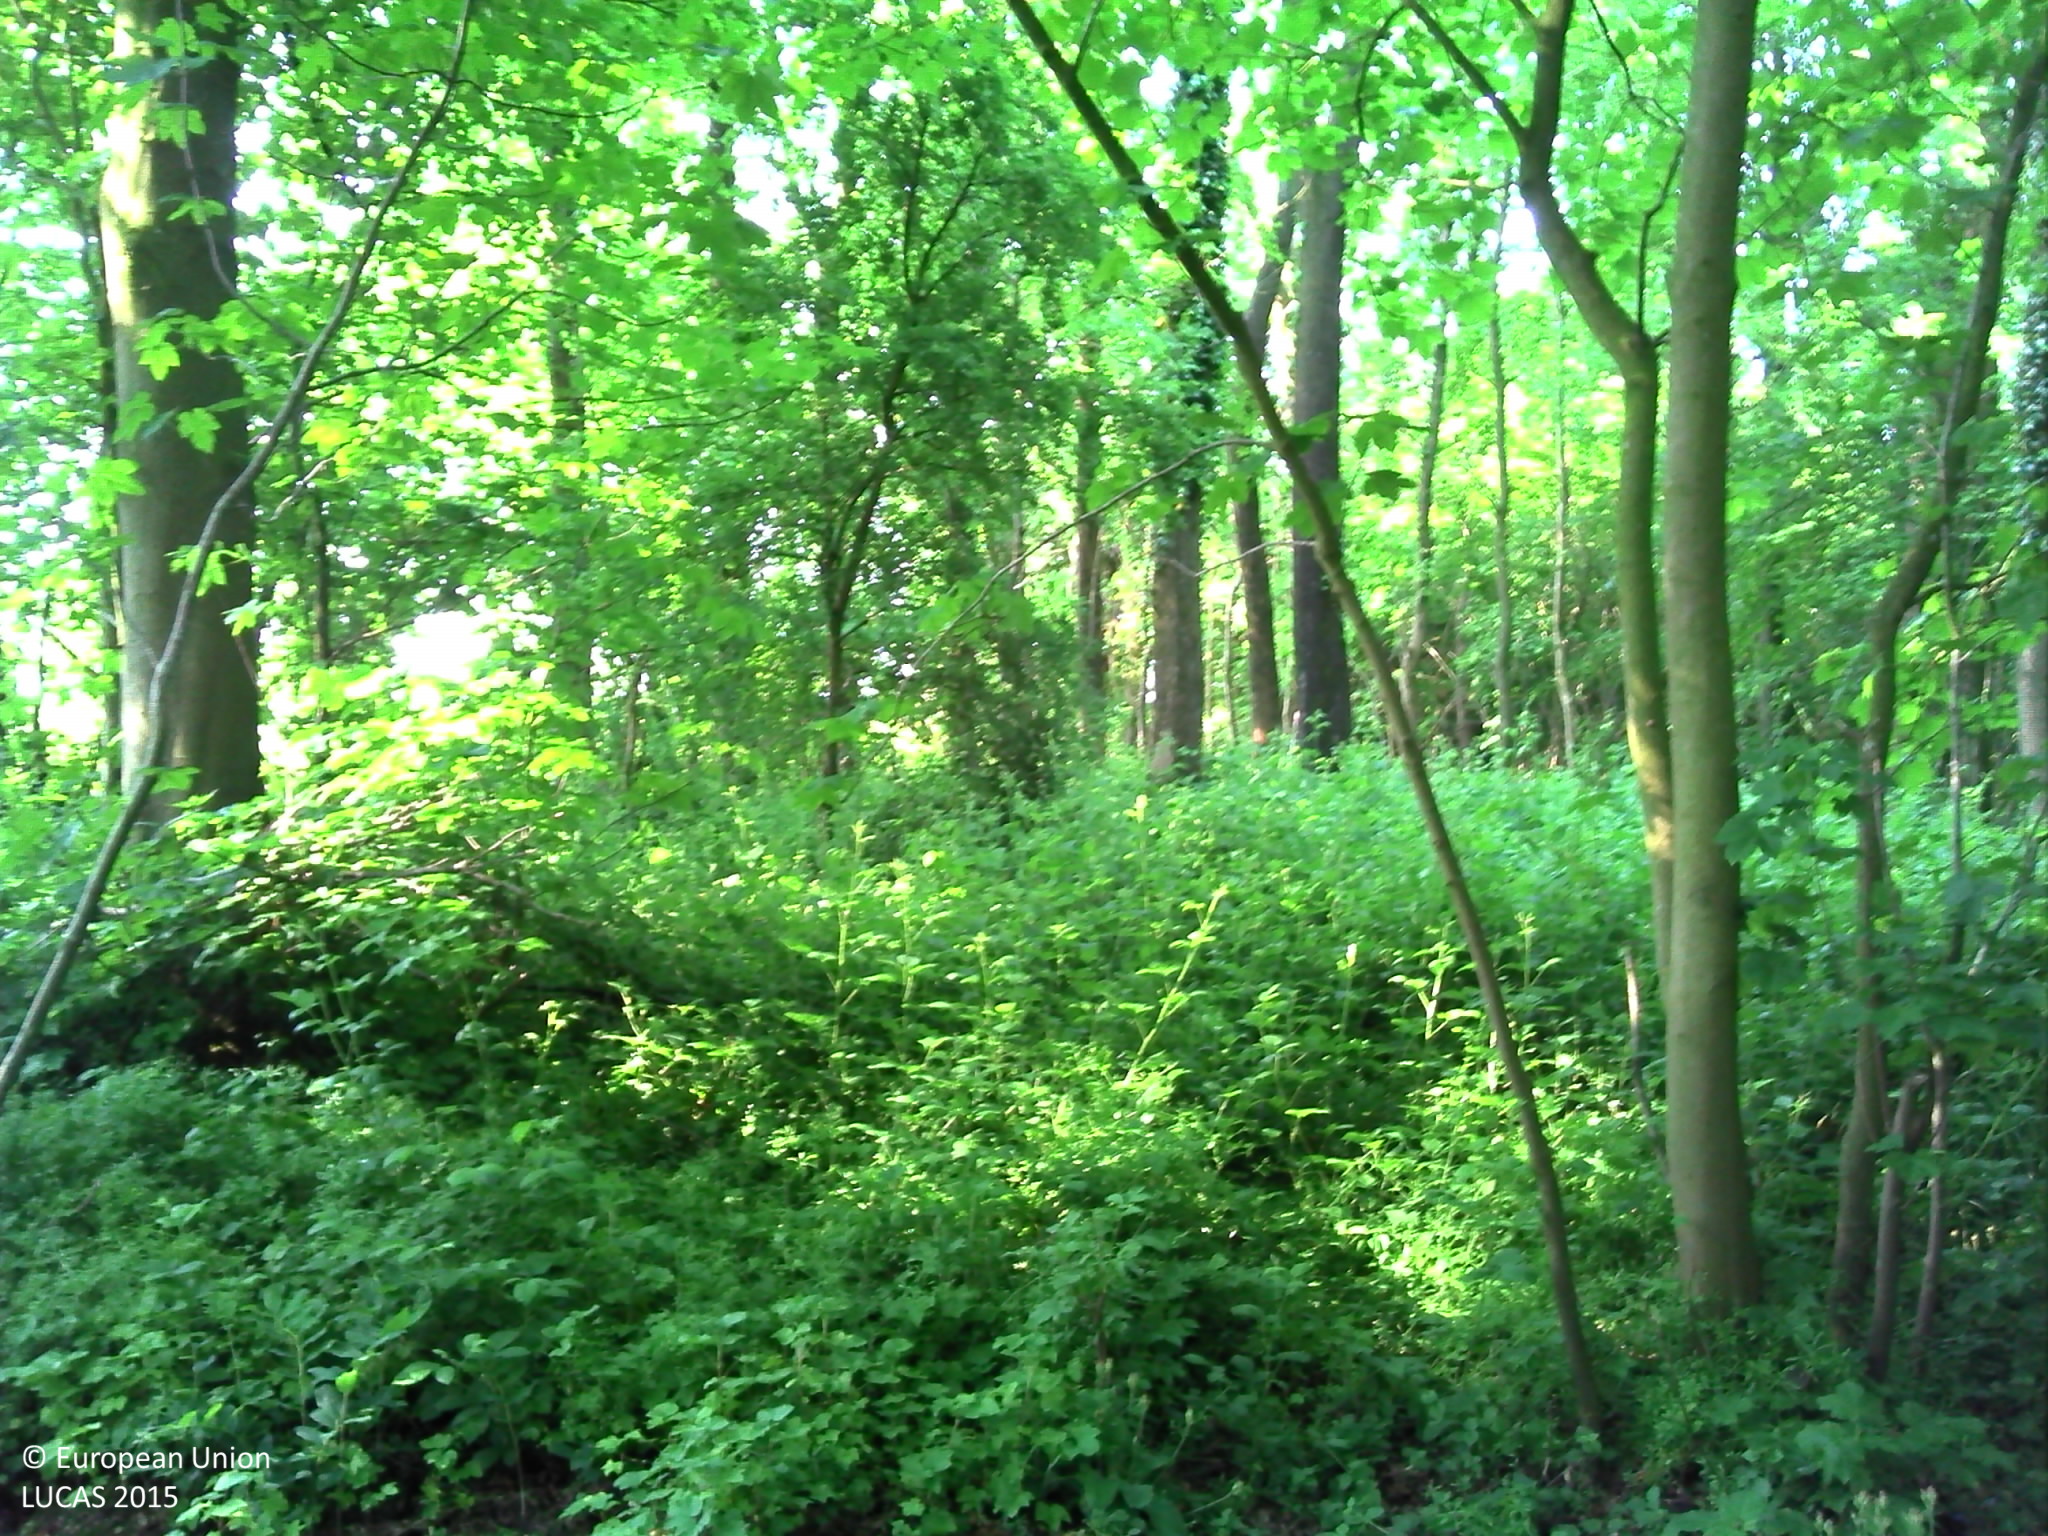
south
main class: Woodland
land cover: Broadleaved woodland
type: mesophytic deciduous forest
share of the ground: > 75 %
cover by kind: broadleaved forest trees 90 %, herbaceous plants 5 %
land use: Forestry
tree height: > 5 m
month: June
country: FR
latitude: 50.5401
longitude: 2.0688
